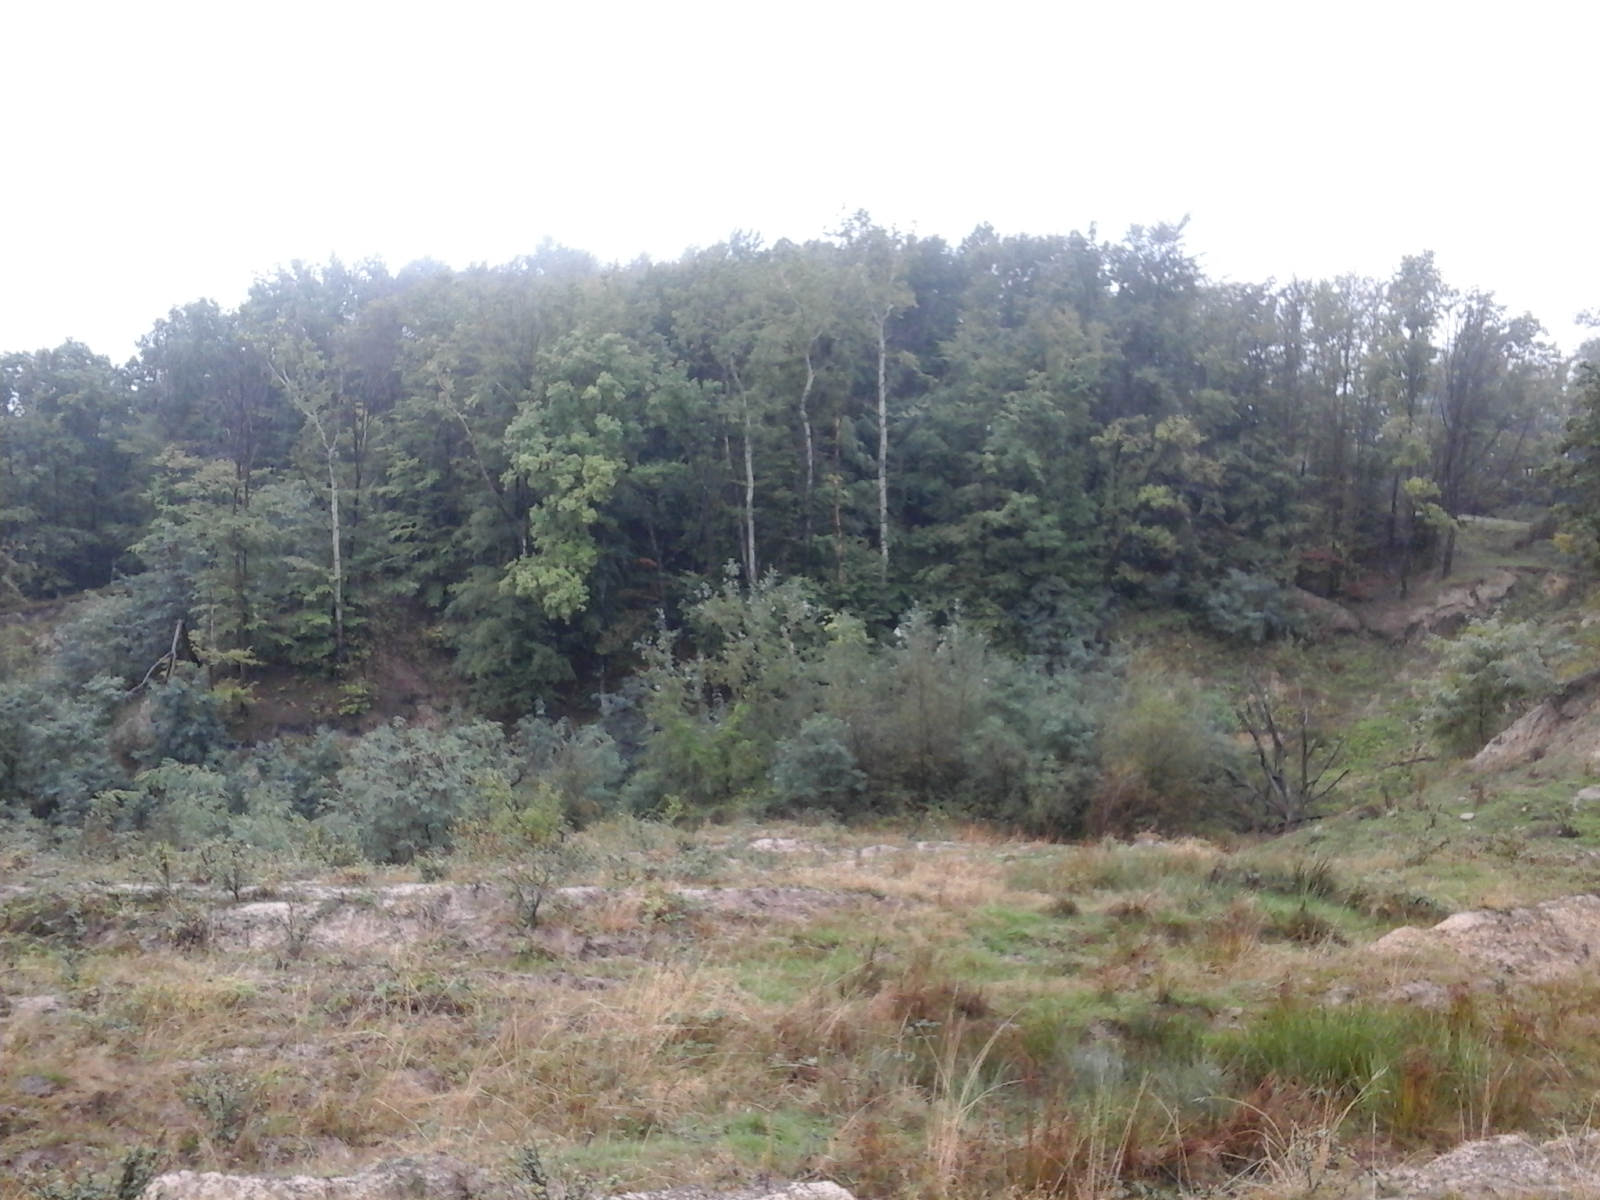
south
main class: Grassland
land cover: Spontaneously vegetated surfaces
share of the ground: > 75 %
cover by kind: herbaceous plants 100 %
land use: Fallow land
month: September
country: RO
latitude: 44.9839
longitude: 23.7456
